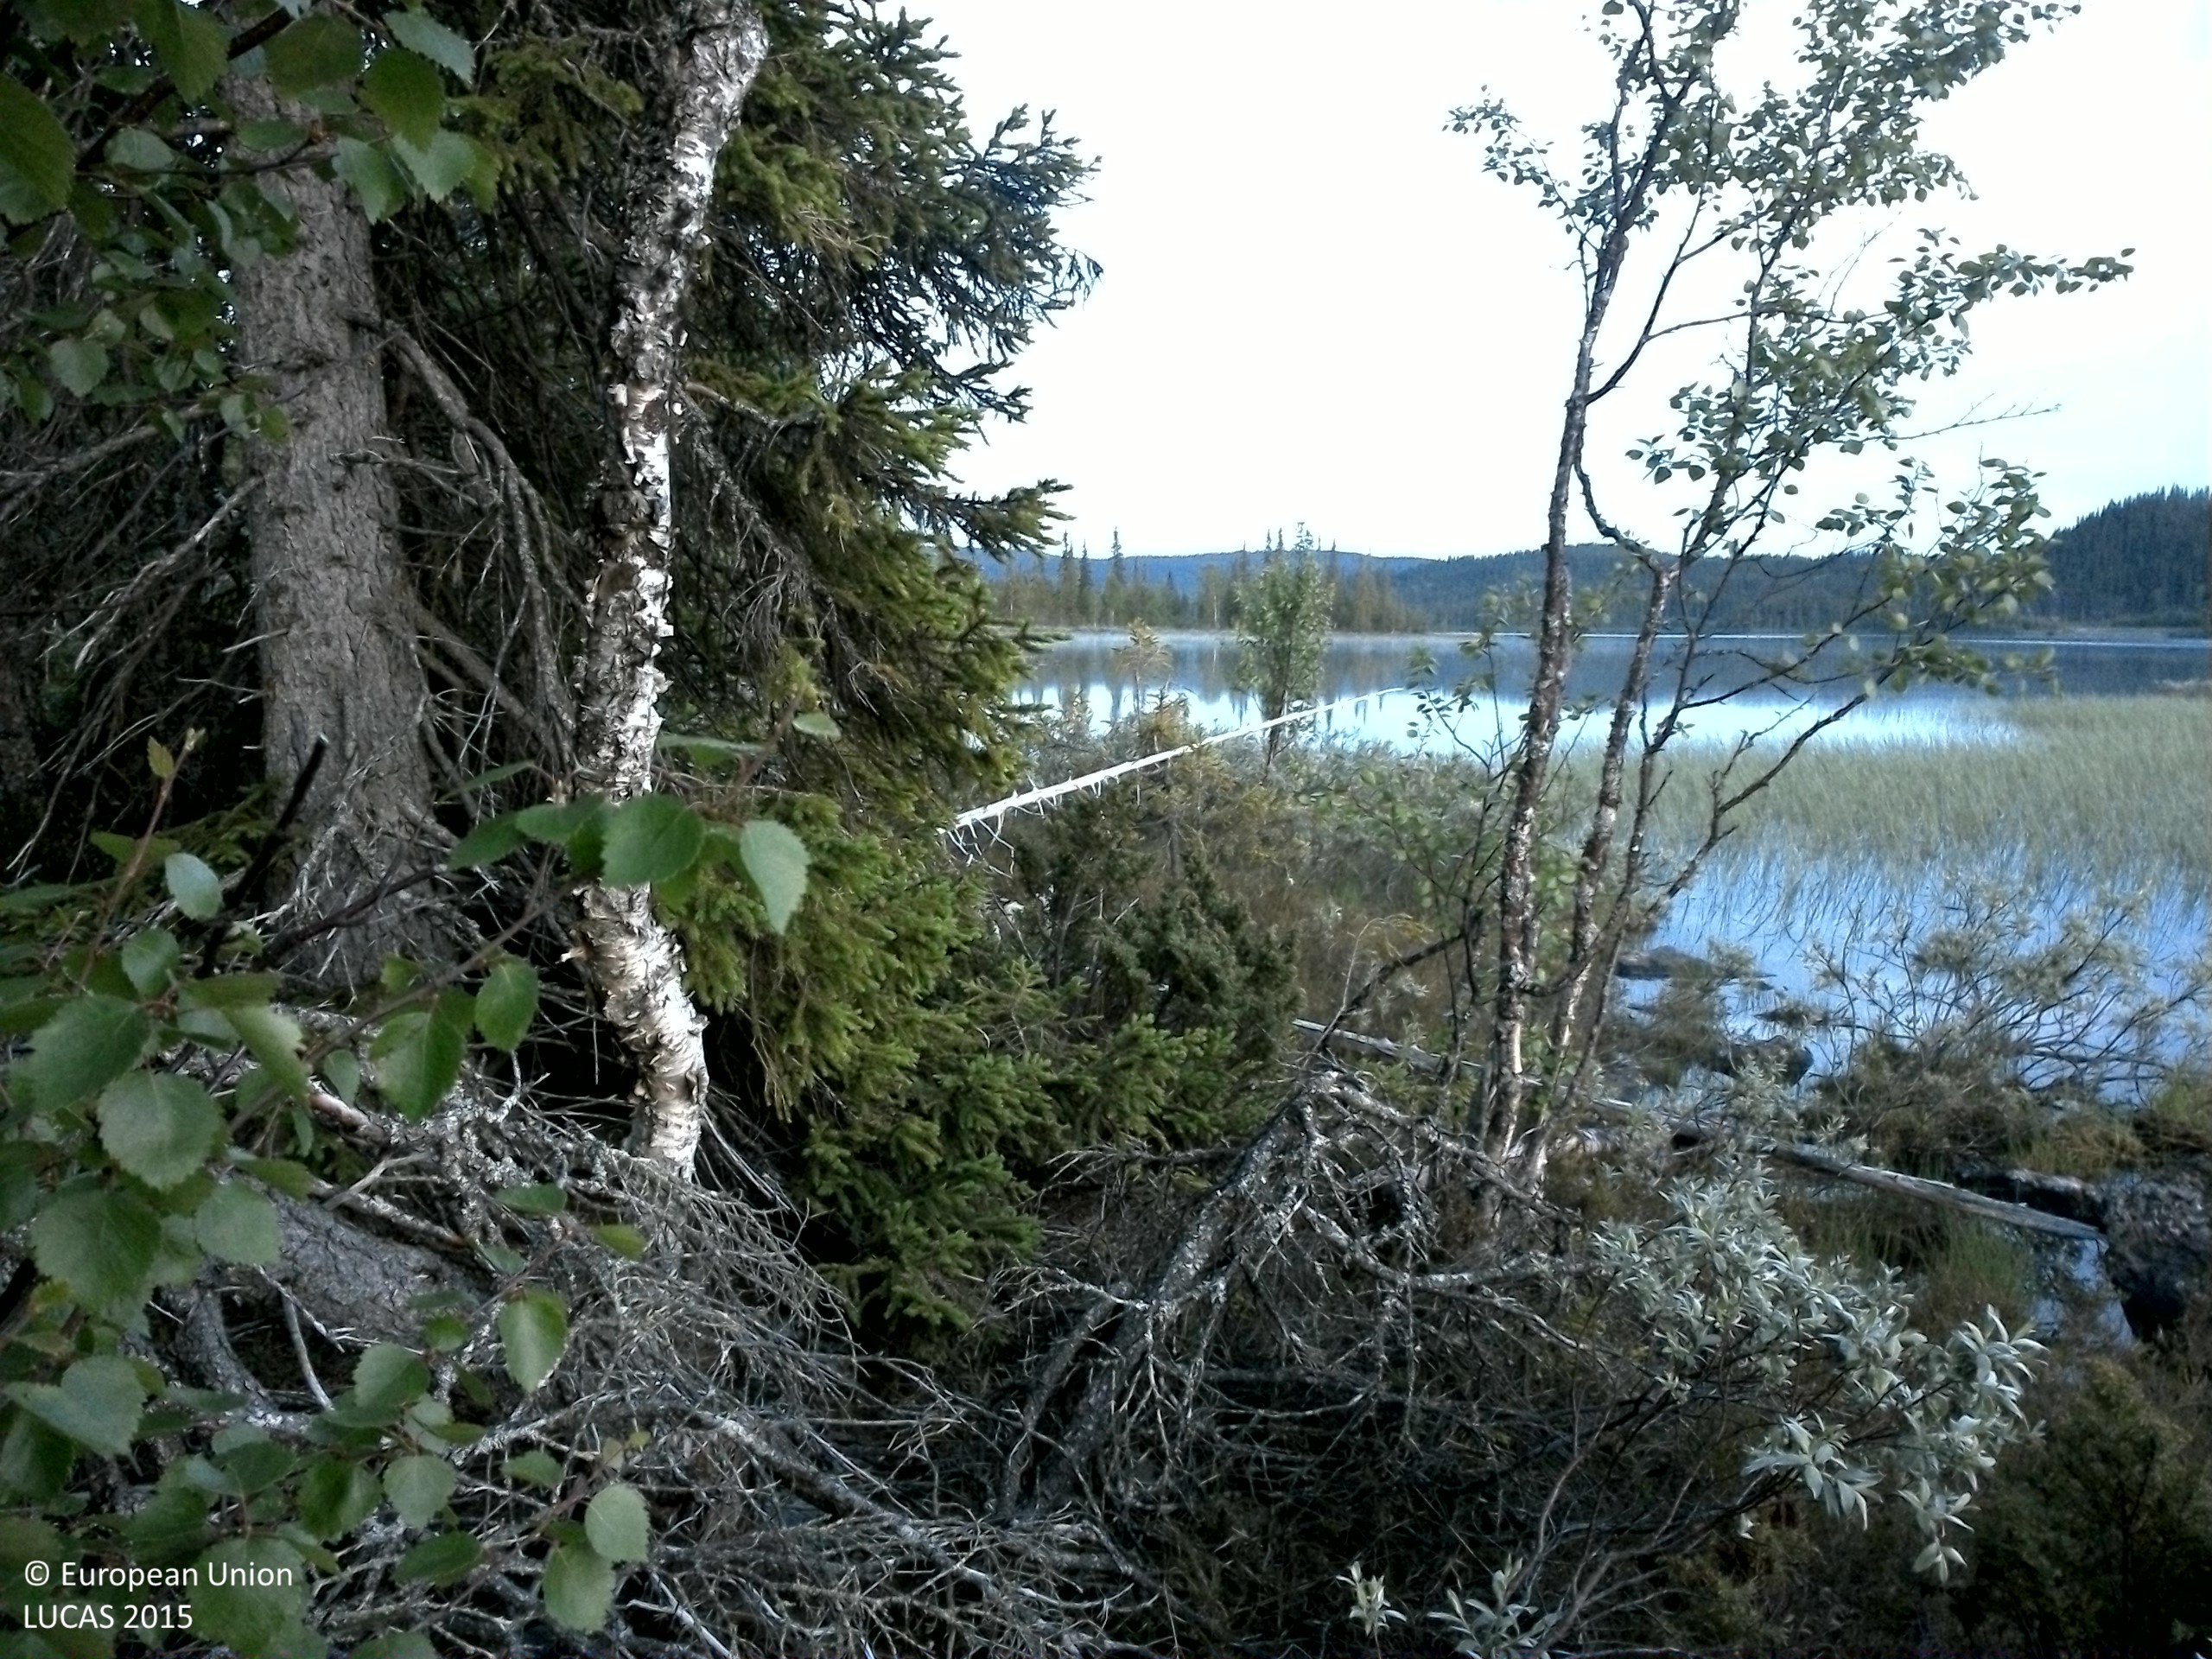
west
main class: Woodland
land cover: Spruce dominated mixed woodland
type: boreal forest
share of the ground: 50 - 75 %
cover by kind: coniferous forest trees 35 %, shrubs 35 %, broadleaved forest trees 15 %, herbaceous plants 10 %, consolidated bare surface 5 %
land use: Forestry
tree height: > 5 m
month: July
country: SE
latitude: 64.7792
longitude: 15.3327
